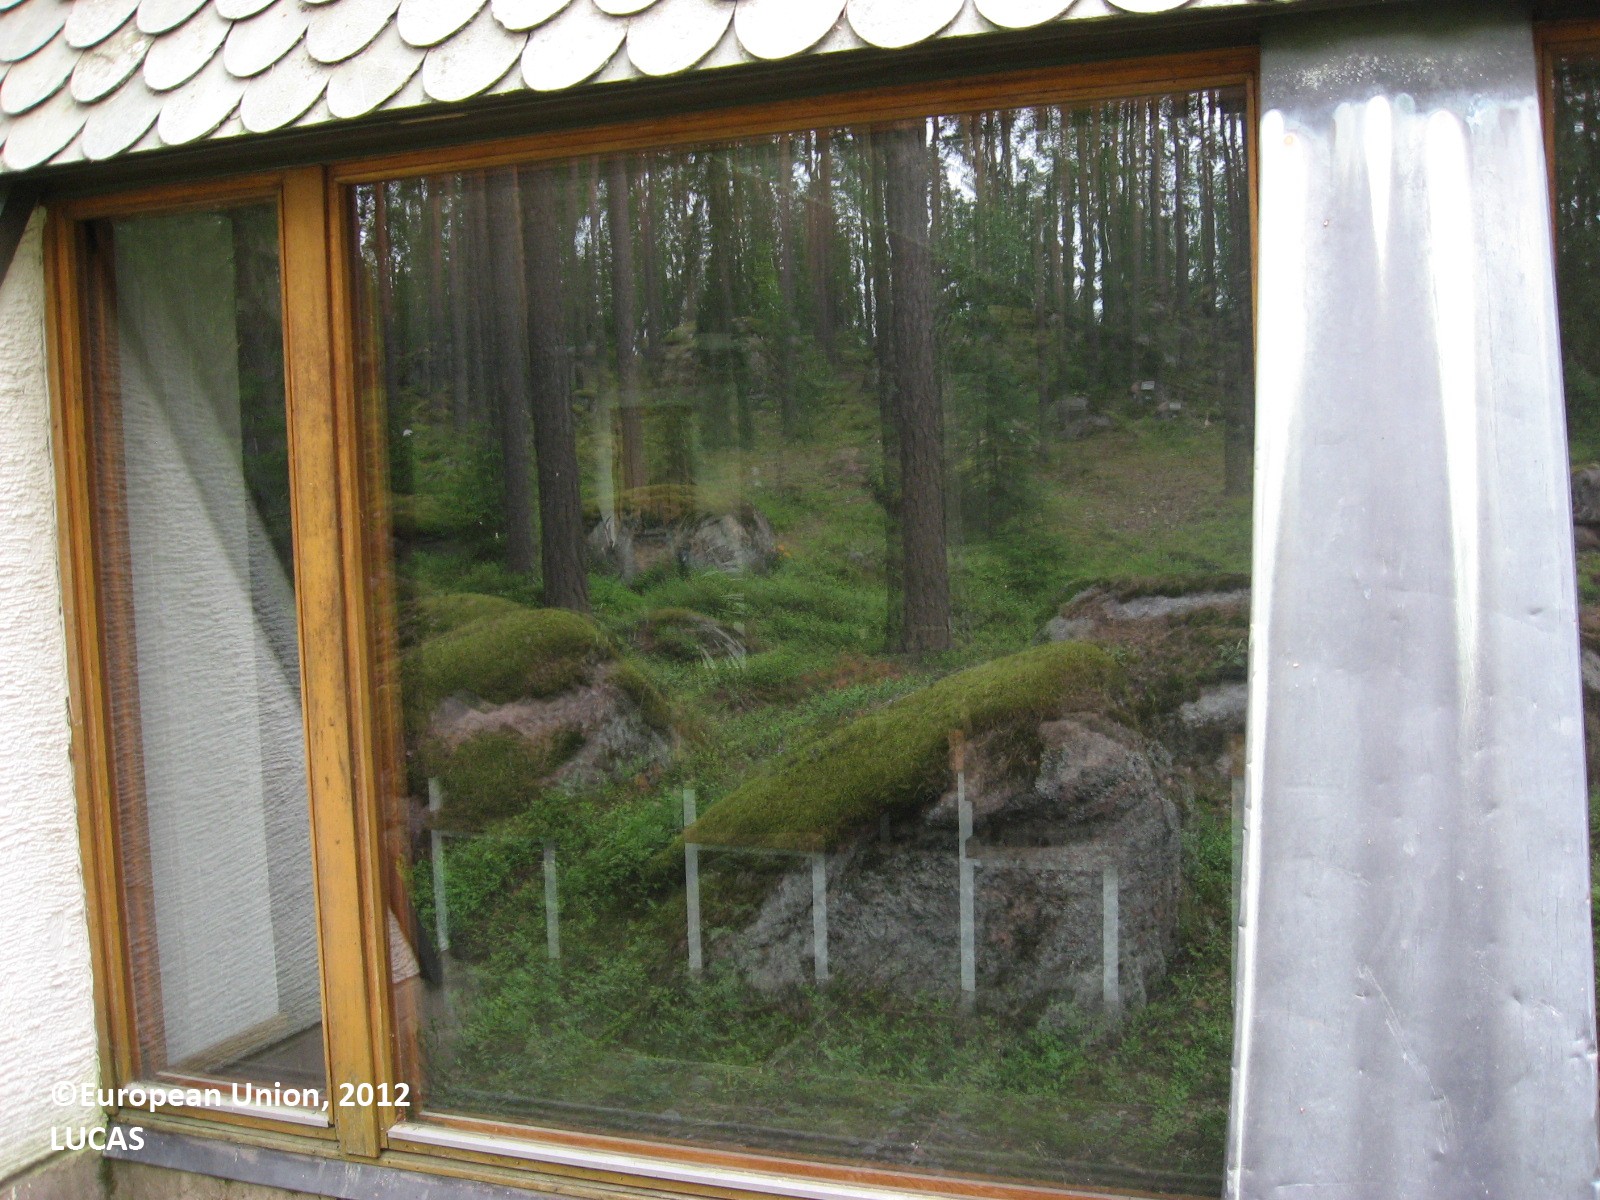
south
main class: Woodland
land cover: Pine dominated coniferous woodland
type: boreal forest
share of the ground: 50 - 75 %
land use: Community services
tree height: > 5 m
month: July
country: FI
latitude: 60.9650
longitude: 25.7392
